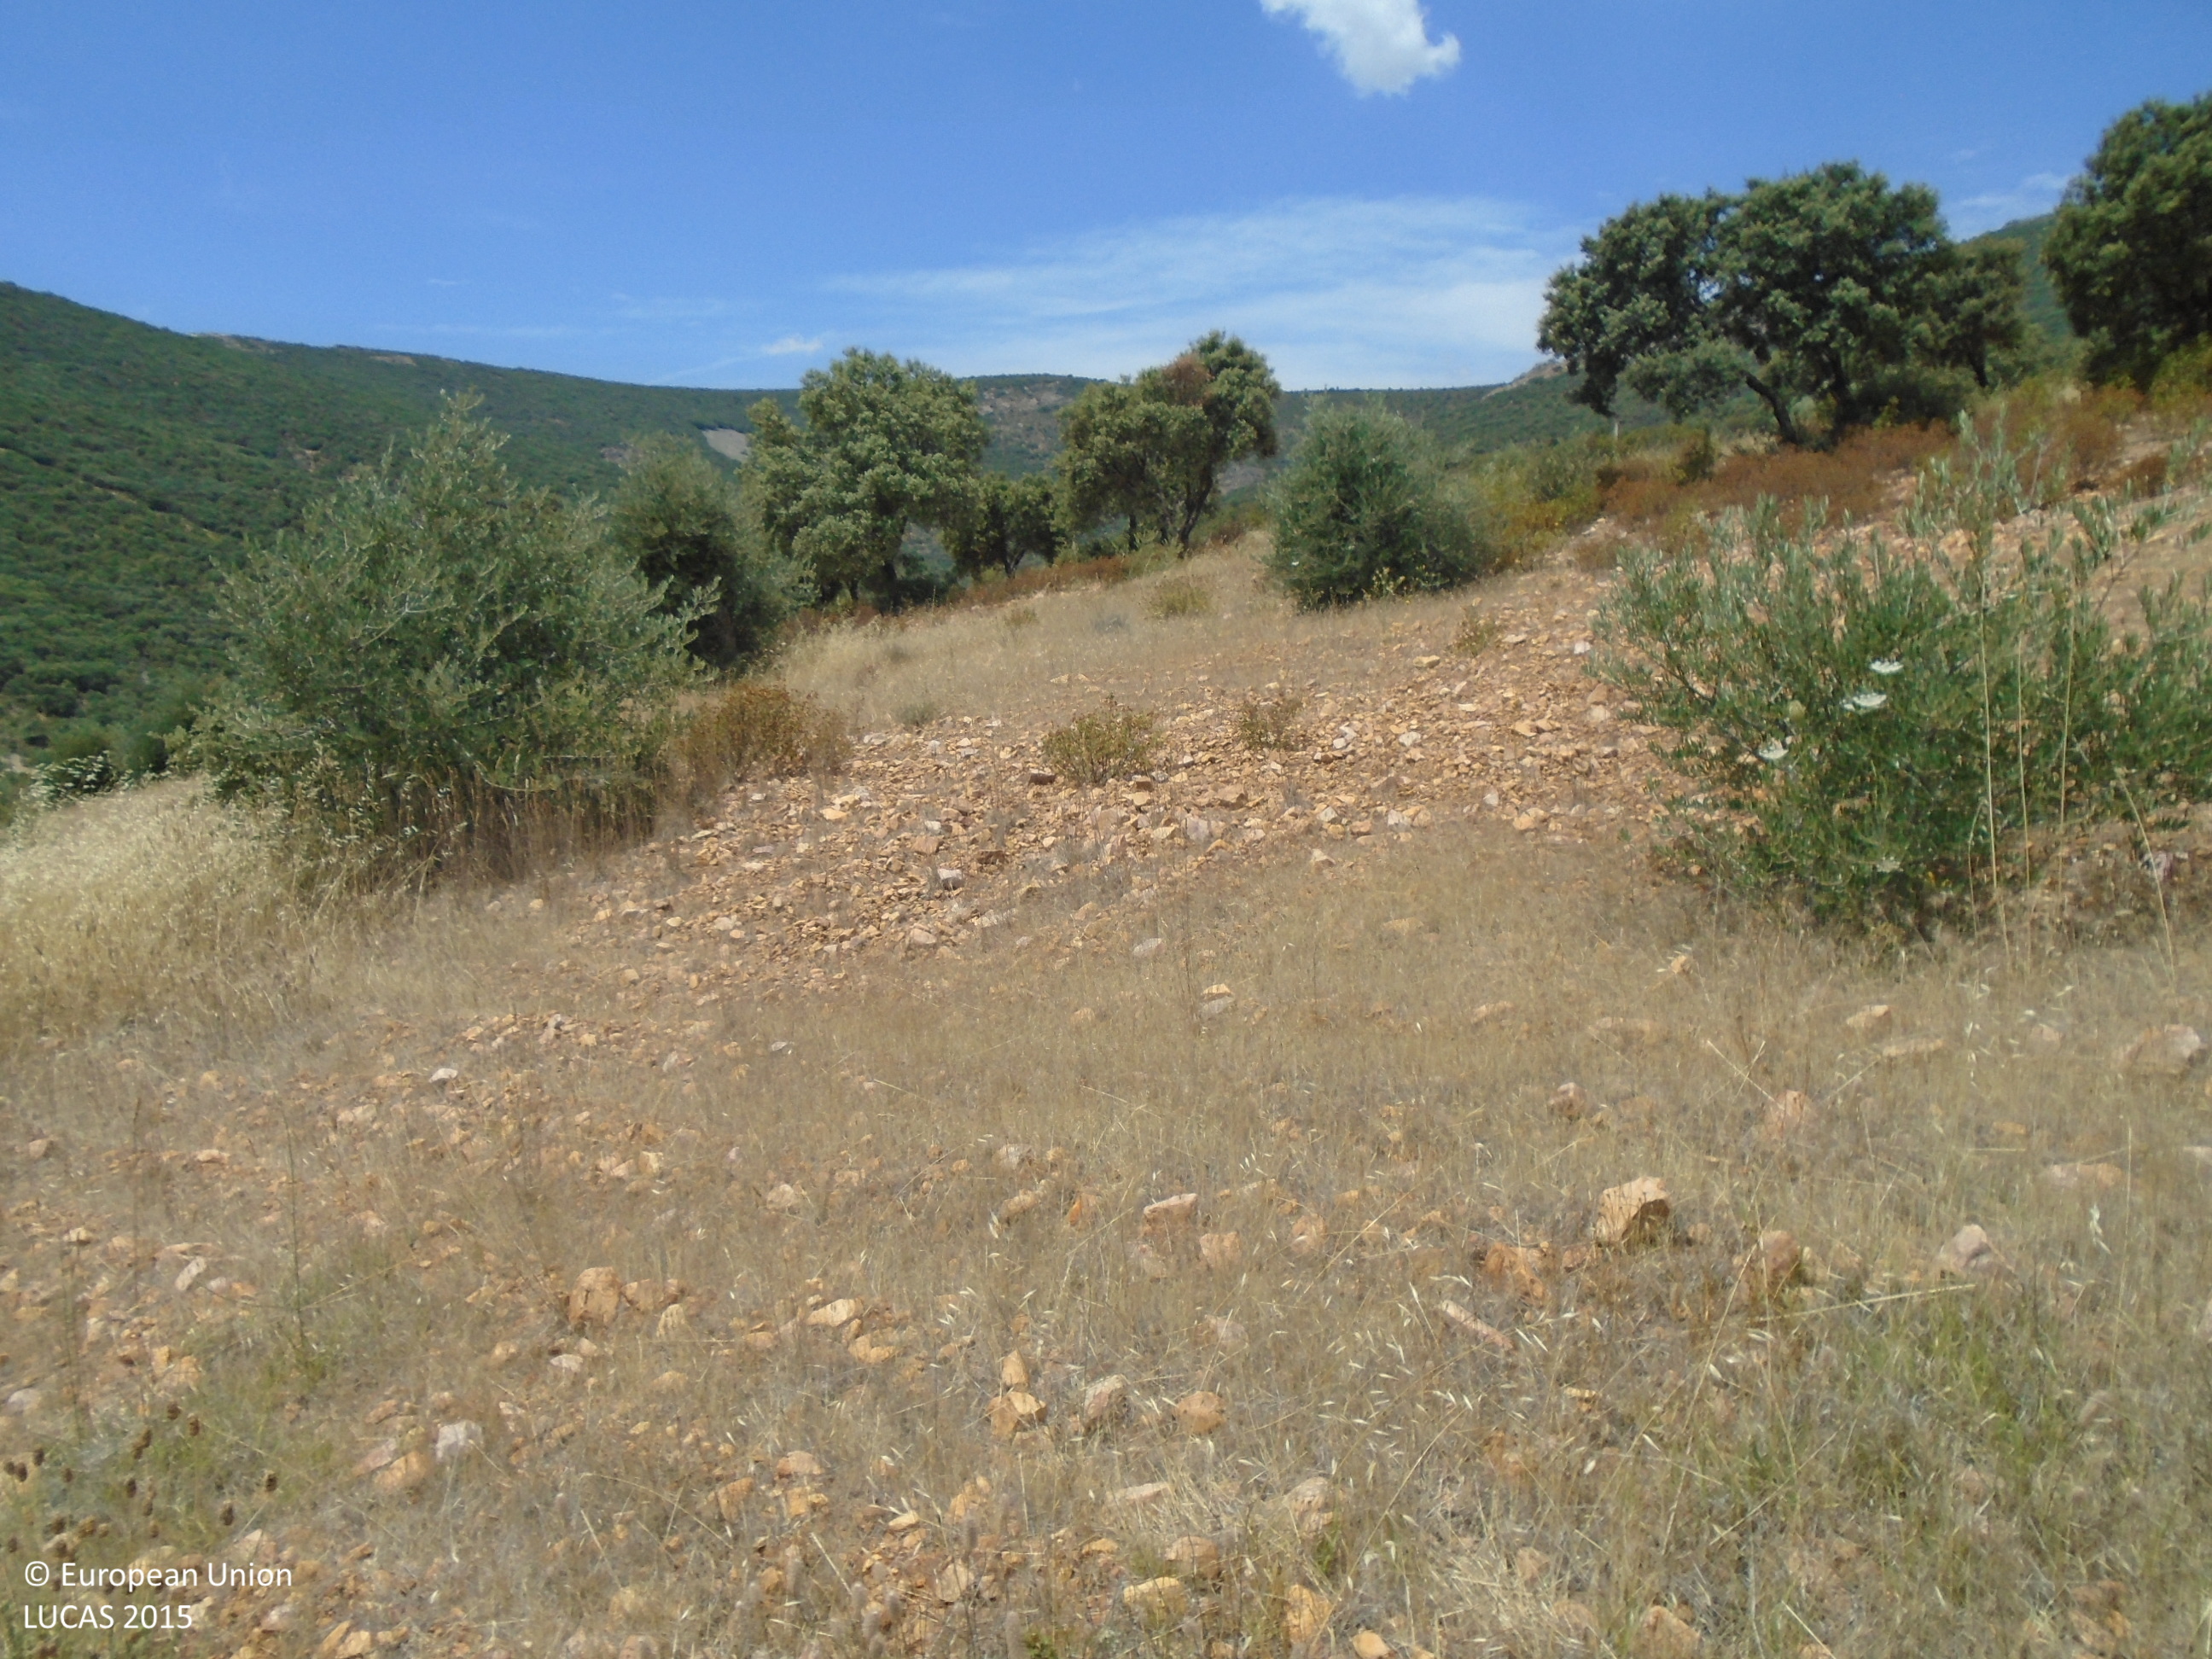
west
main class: Cropland
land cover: Olive groves
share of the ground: 10 - 25 %
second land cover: Spontaneously vegetated surfaces
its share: > 75 %
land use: Agriculture (excluding fallow land and kitchen gardens)
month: June
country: ES
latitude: 39.2374
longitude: -3.6335
